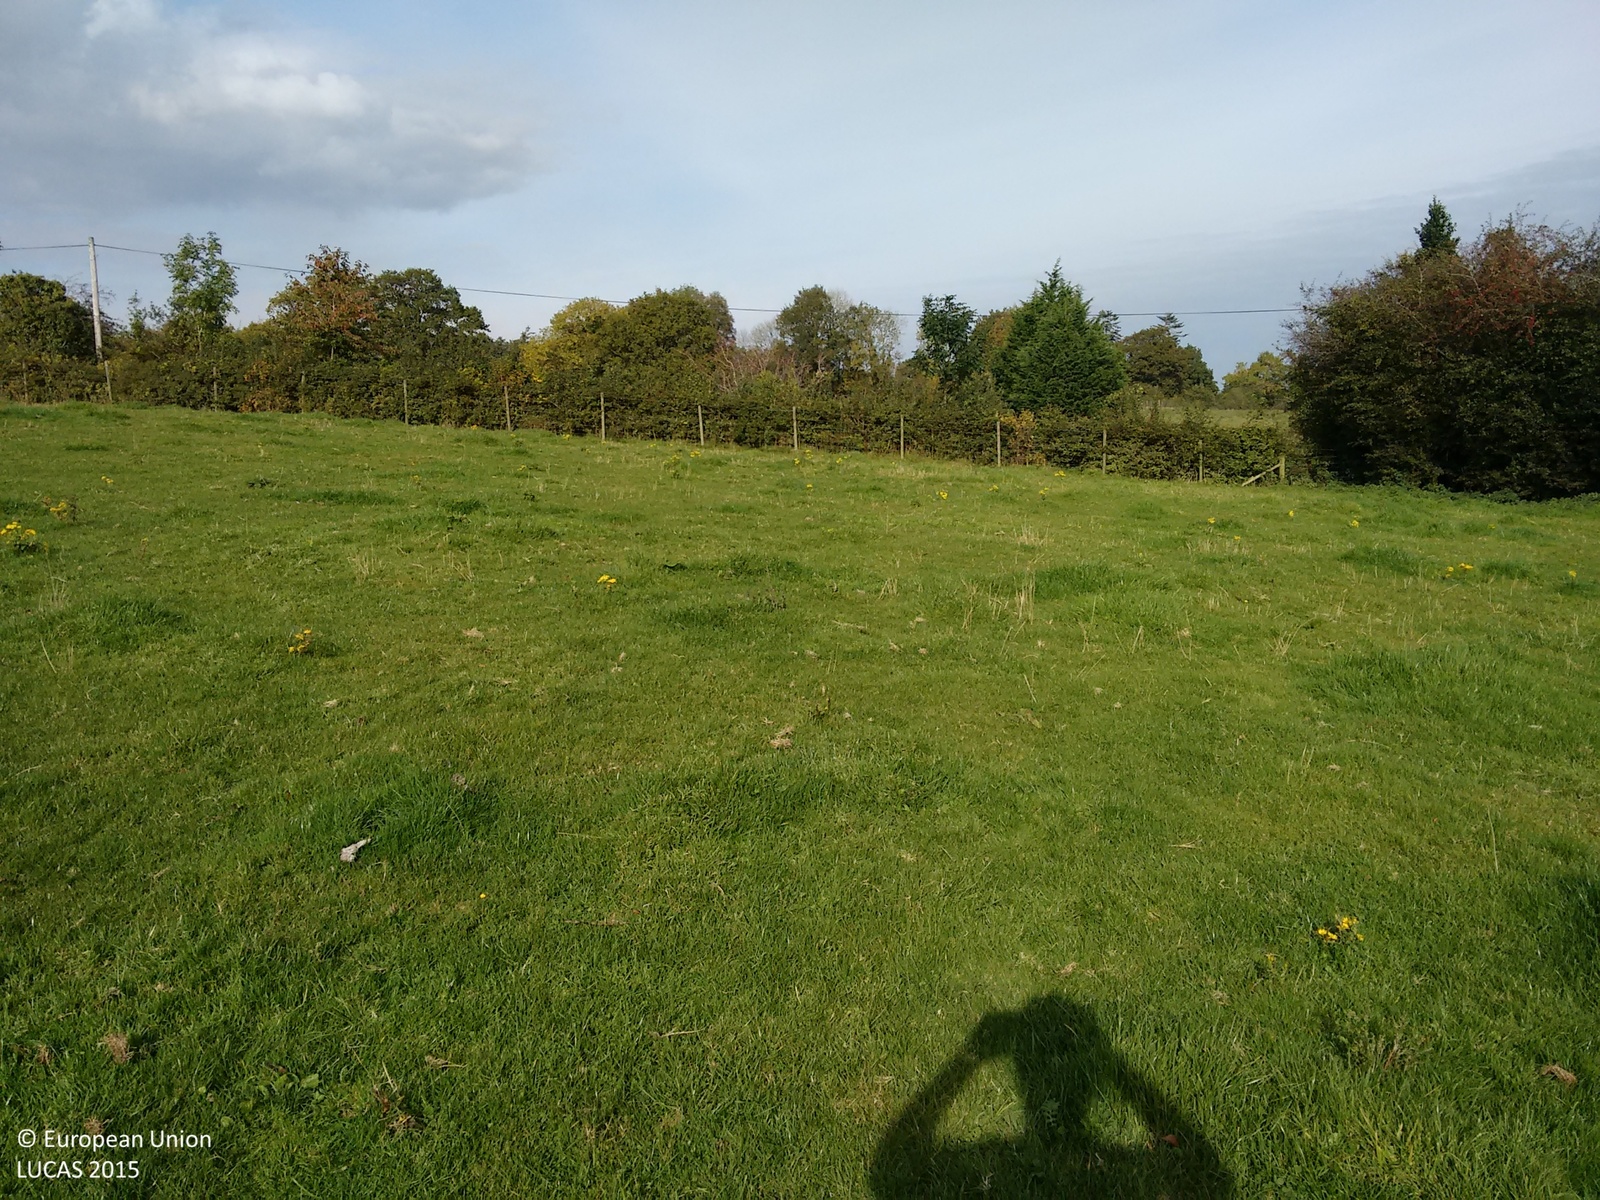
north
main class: Grassland
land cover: Grassland without tree/shrub cover
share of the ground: > 75 %
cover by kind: herbaceous plants 100 %
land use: Agriculture (excluding fallow land and kitchen gardens)
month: October
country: GB
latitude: 54.1837
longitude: -7.5819
